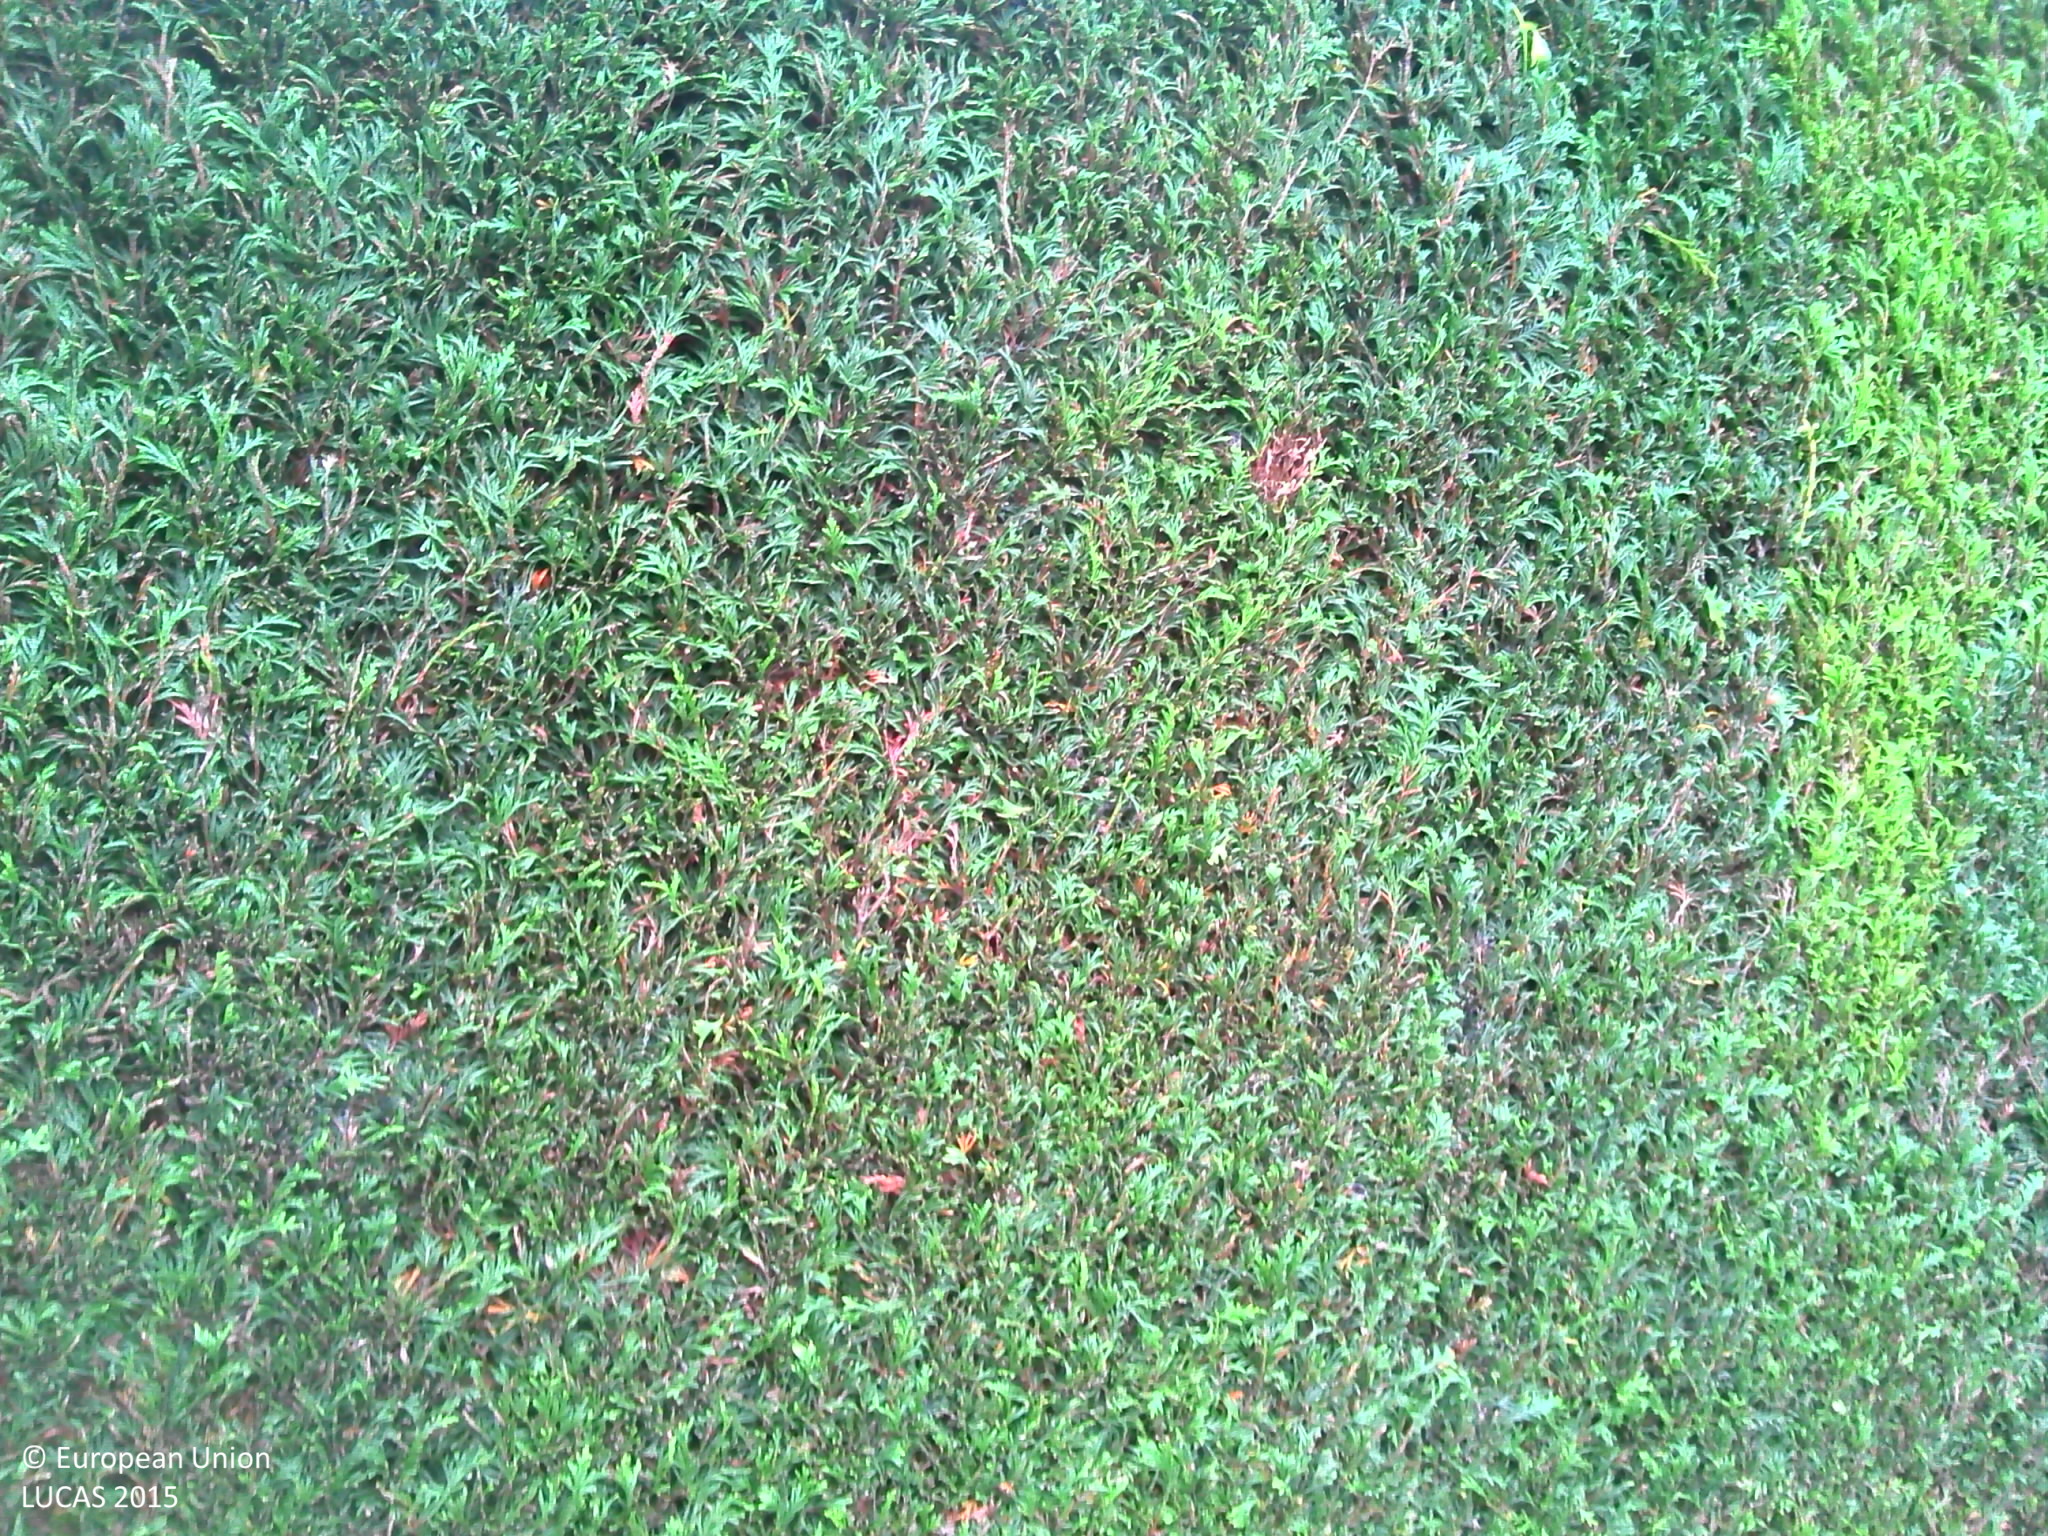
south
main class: Grassland
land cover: Grassland without tree/shrub cover
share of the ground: > 75 %
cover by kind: herbaceous plants 100 %
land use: Residential
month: October
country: BE
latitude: 50.9565
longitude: 2.9140
